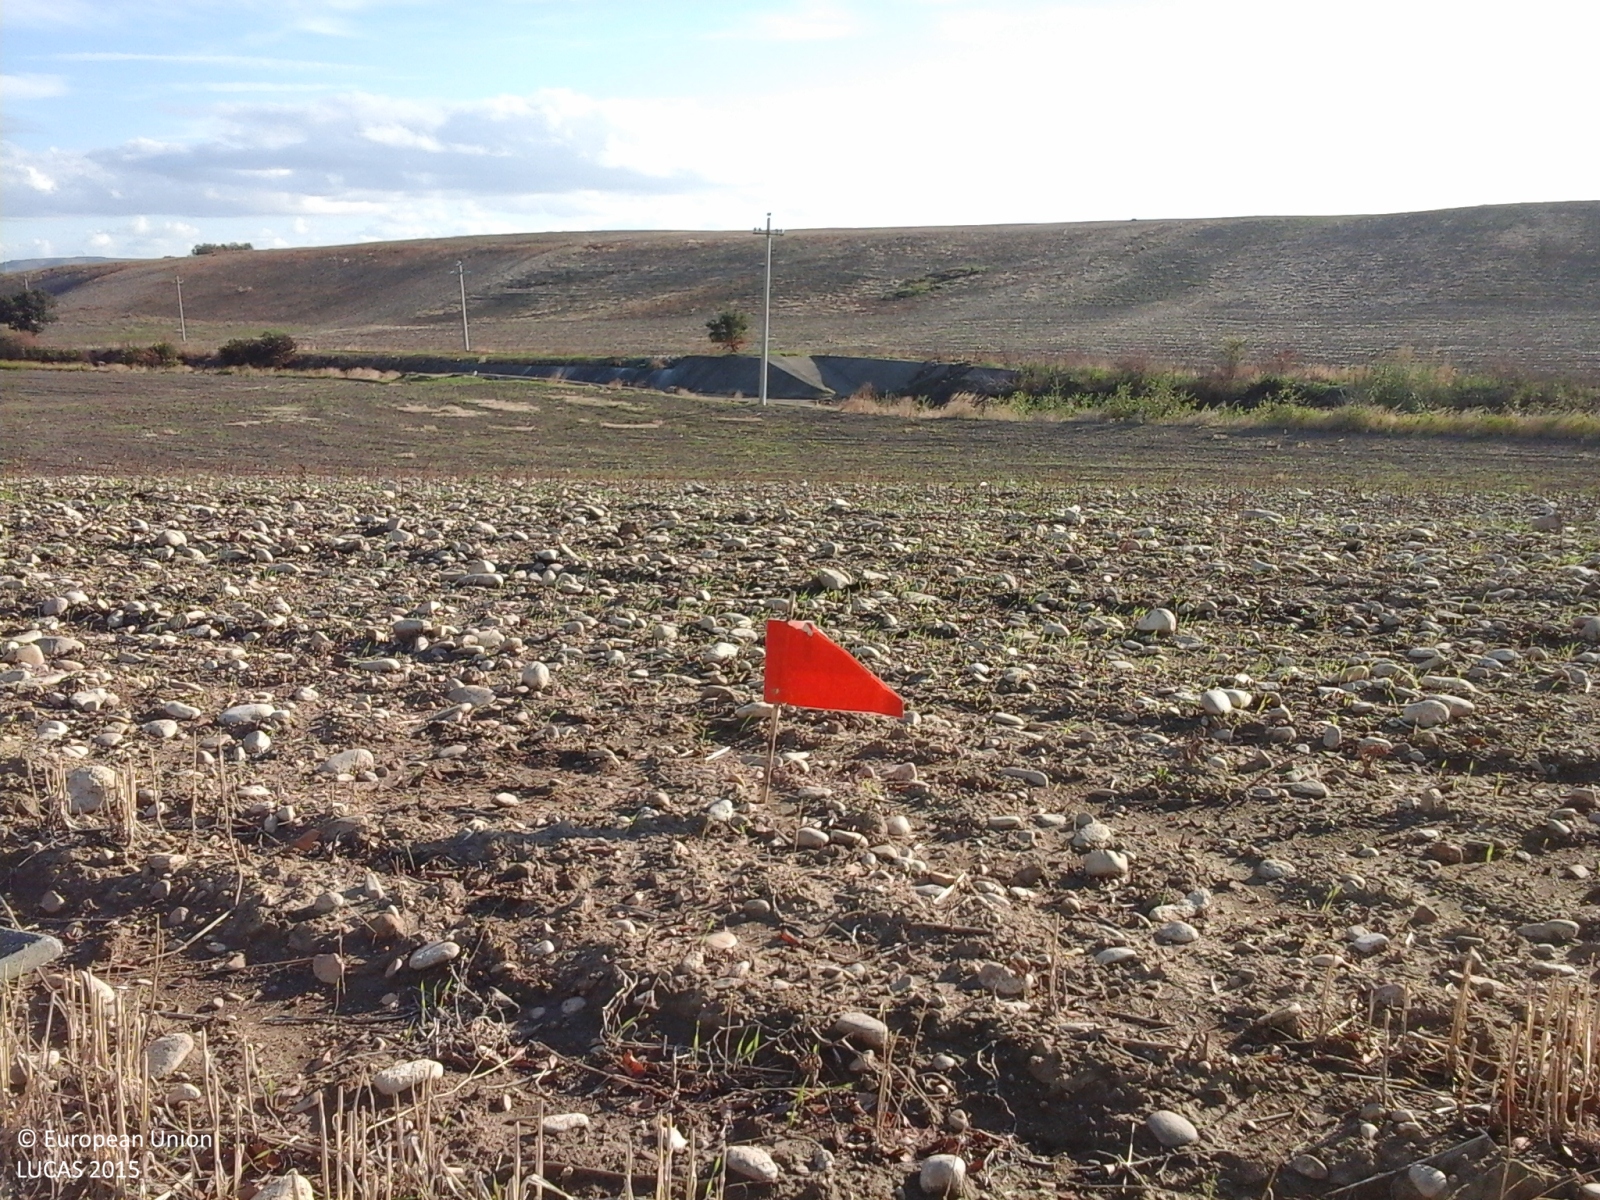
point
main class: Cropland
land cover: Barley
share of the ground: > 75 %
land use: Agriculture (excluding fallow land and kitchen gardens)
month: September
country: IT
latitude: 41.7066
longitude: 15.1871
